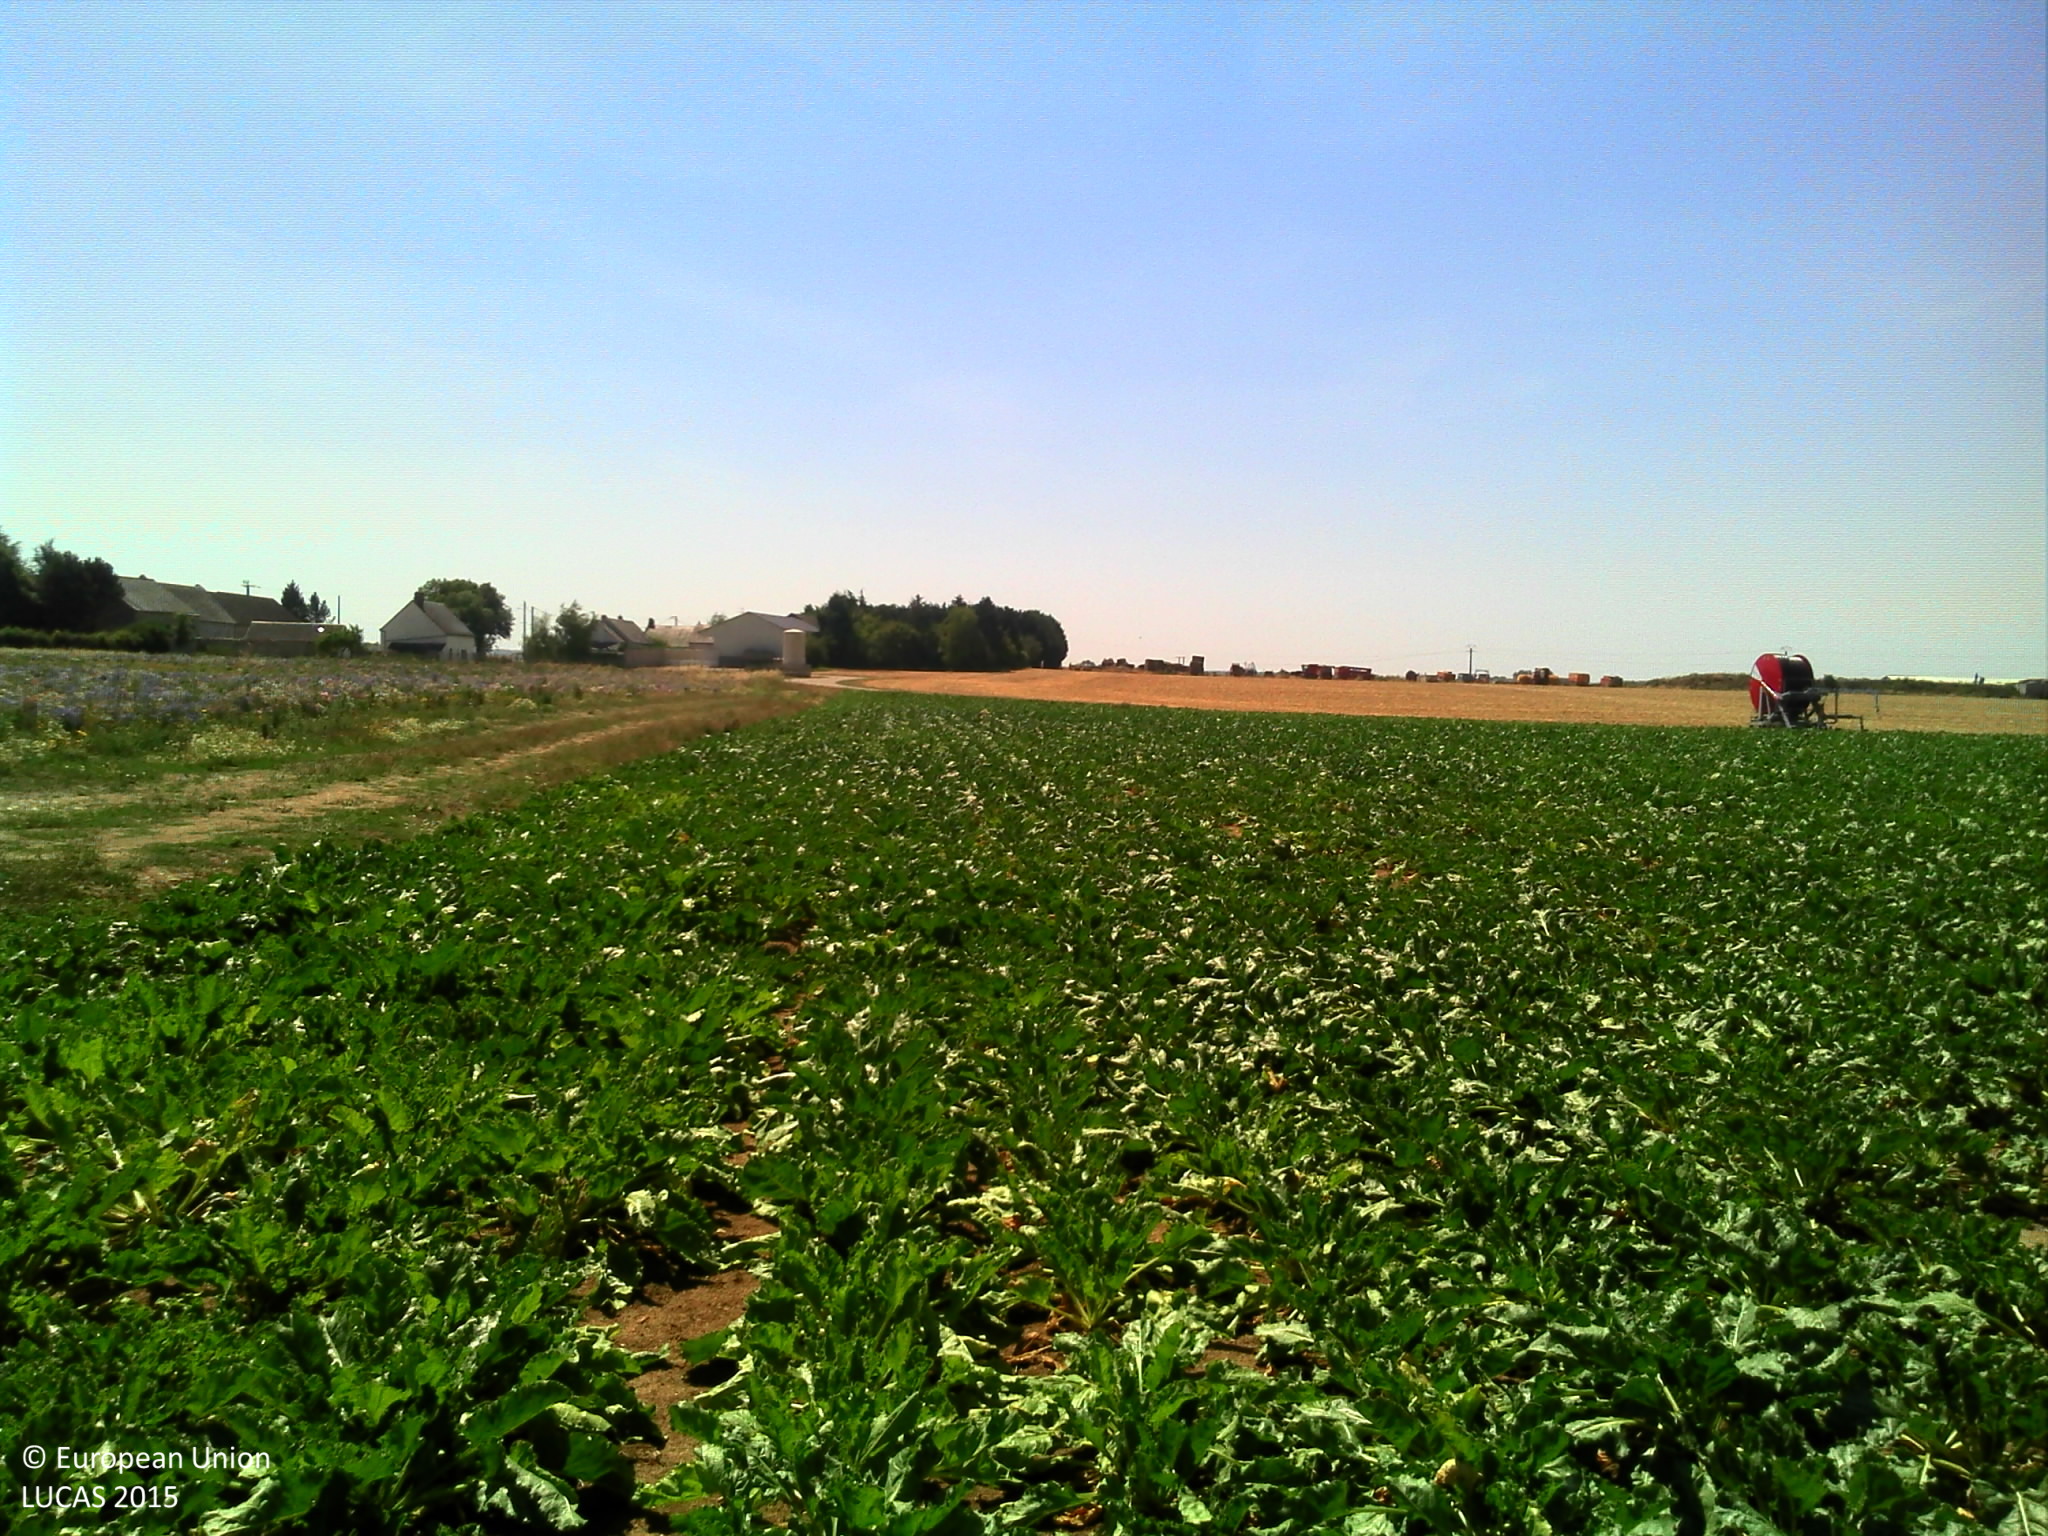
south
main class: Cropland
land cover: Sugar beet
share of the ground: > 75 %
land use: Agriculture (excluding fallow land and kitchen gardens)
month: August
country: FR
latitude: 48.1091
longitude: 1.9420
